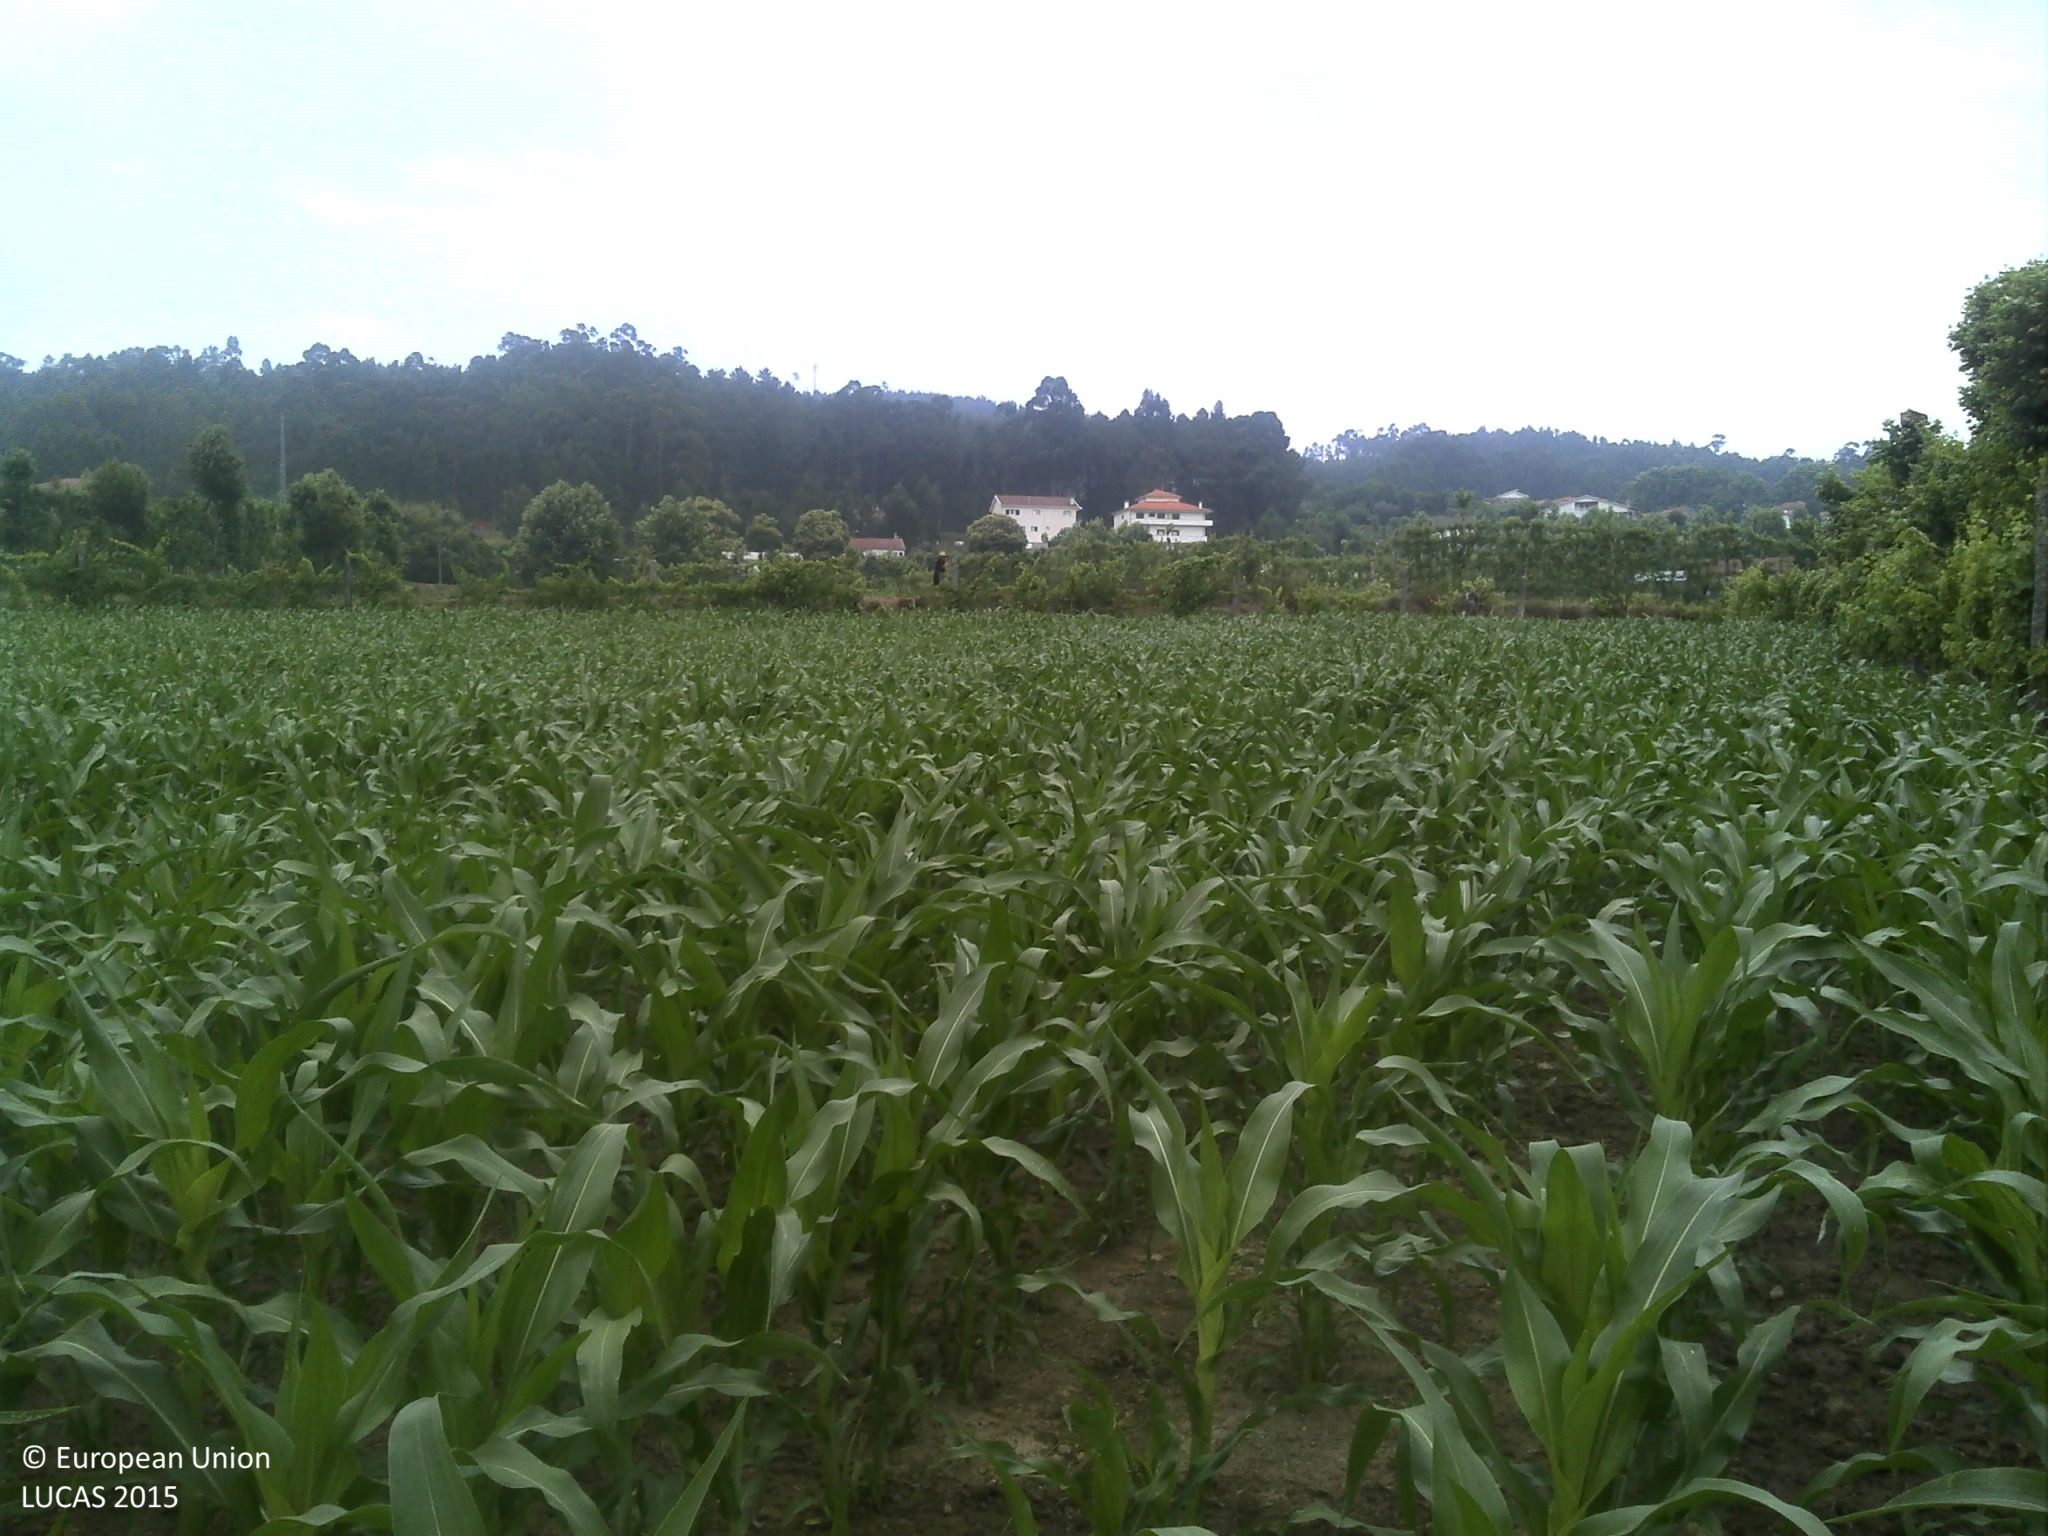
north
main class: Cropland
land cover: Maize
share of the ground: > 75 %
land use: Agriculture (excluding fallow land and kitchen gardens)
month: June
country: PT
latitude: 41.2958
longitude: -8.2363
